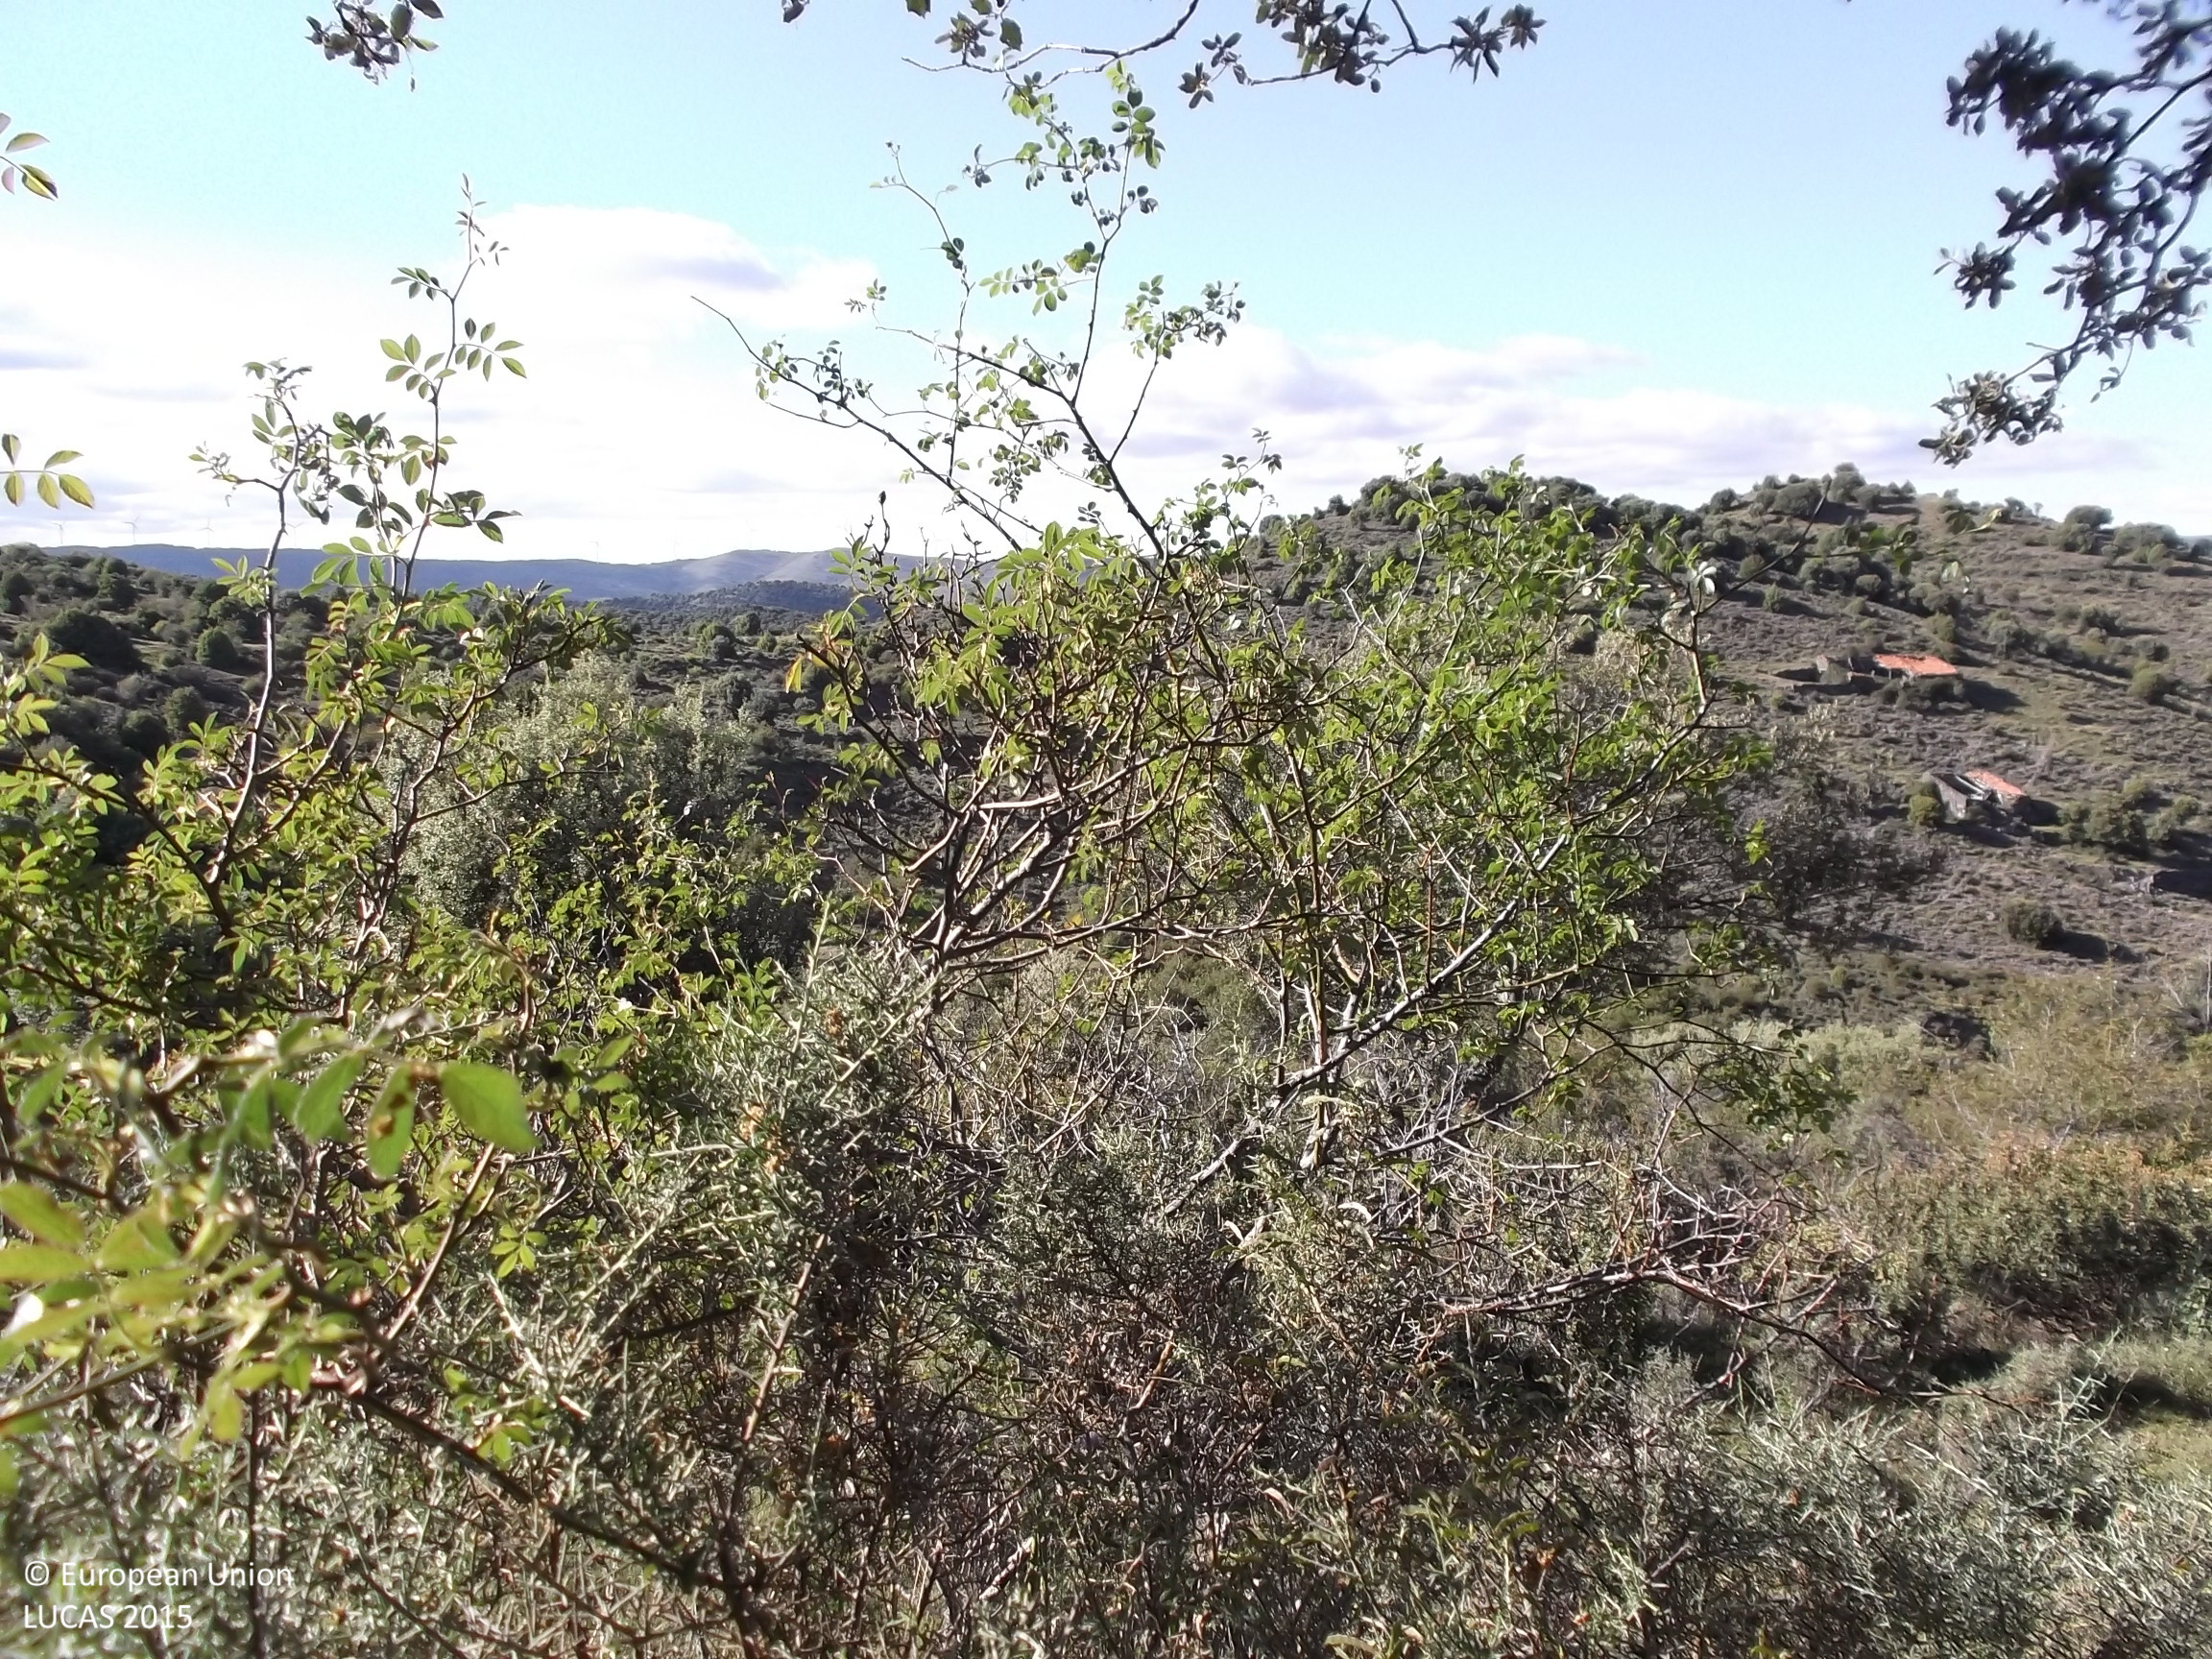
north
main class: Woodland
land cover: Broadleaved woodland
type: broadleaved evergreen forest
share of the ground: 10 - 25 %
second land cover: Shrubland without tree cover
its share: 50 - 75 %
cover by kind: shrubs 50 %, herbaceous plants 30 %, broadleaved forest trees 10 %, unconsolidated bare surface 5 %
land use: Forestry
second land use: Agriculture (excluding fallow land and kitchen gardens)
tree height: < 5 m
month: June
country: ES
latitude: 42.1568
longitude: -2.2999
